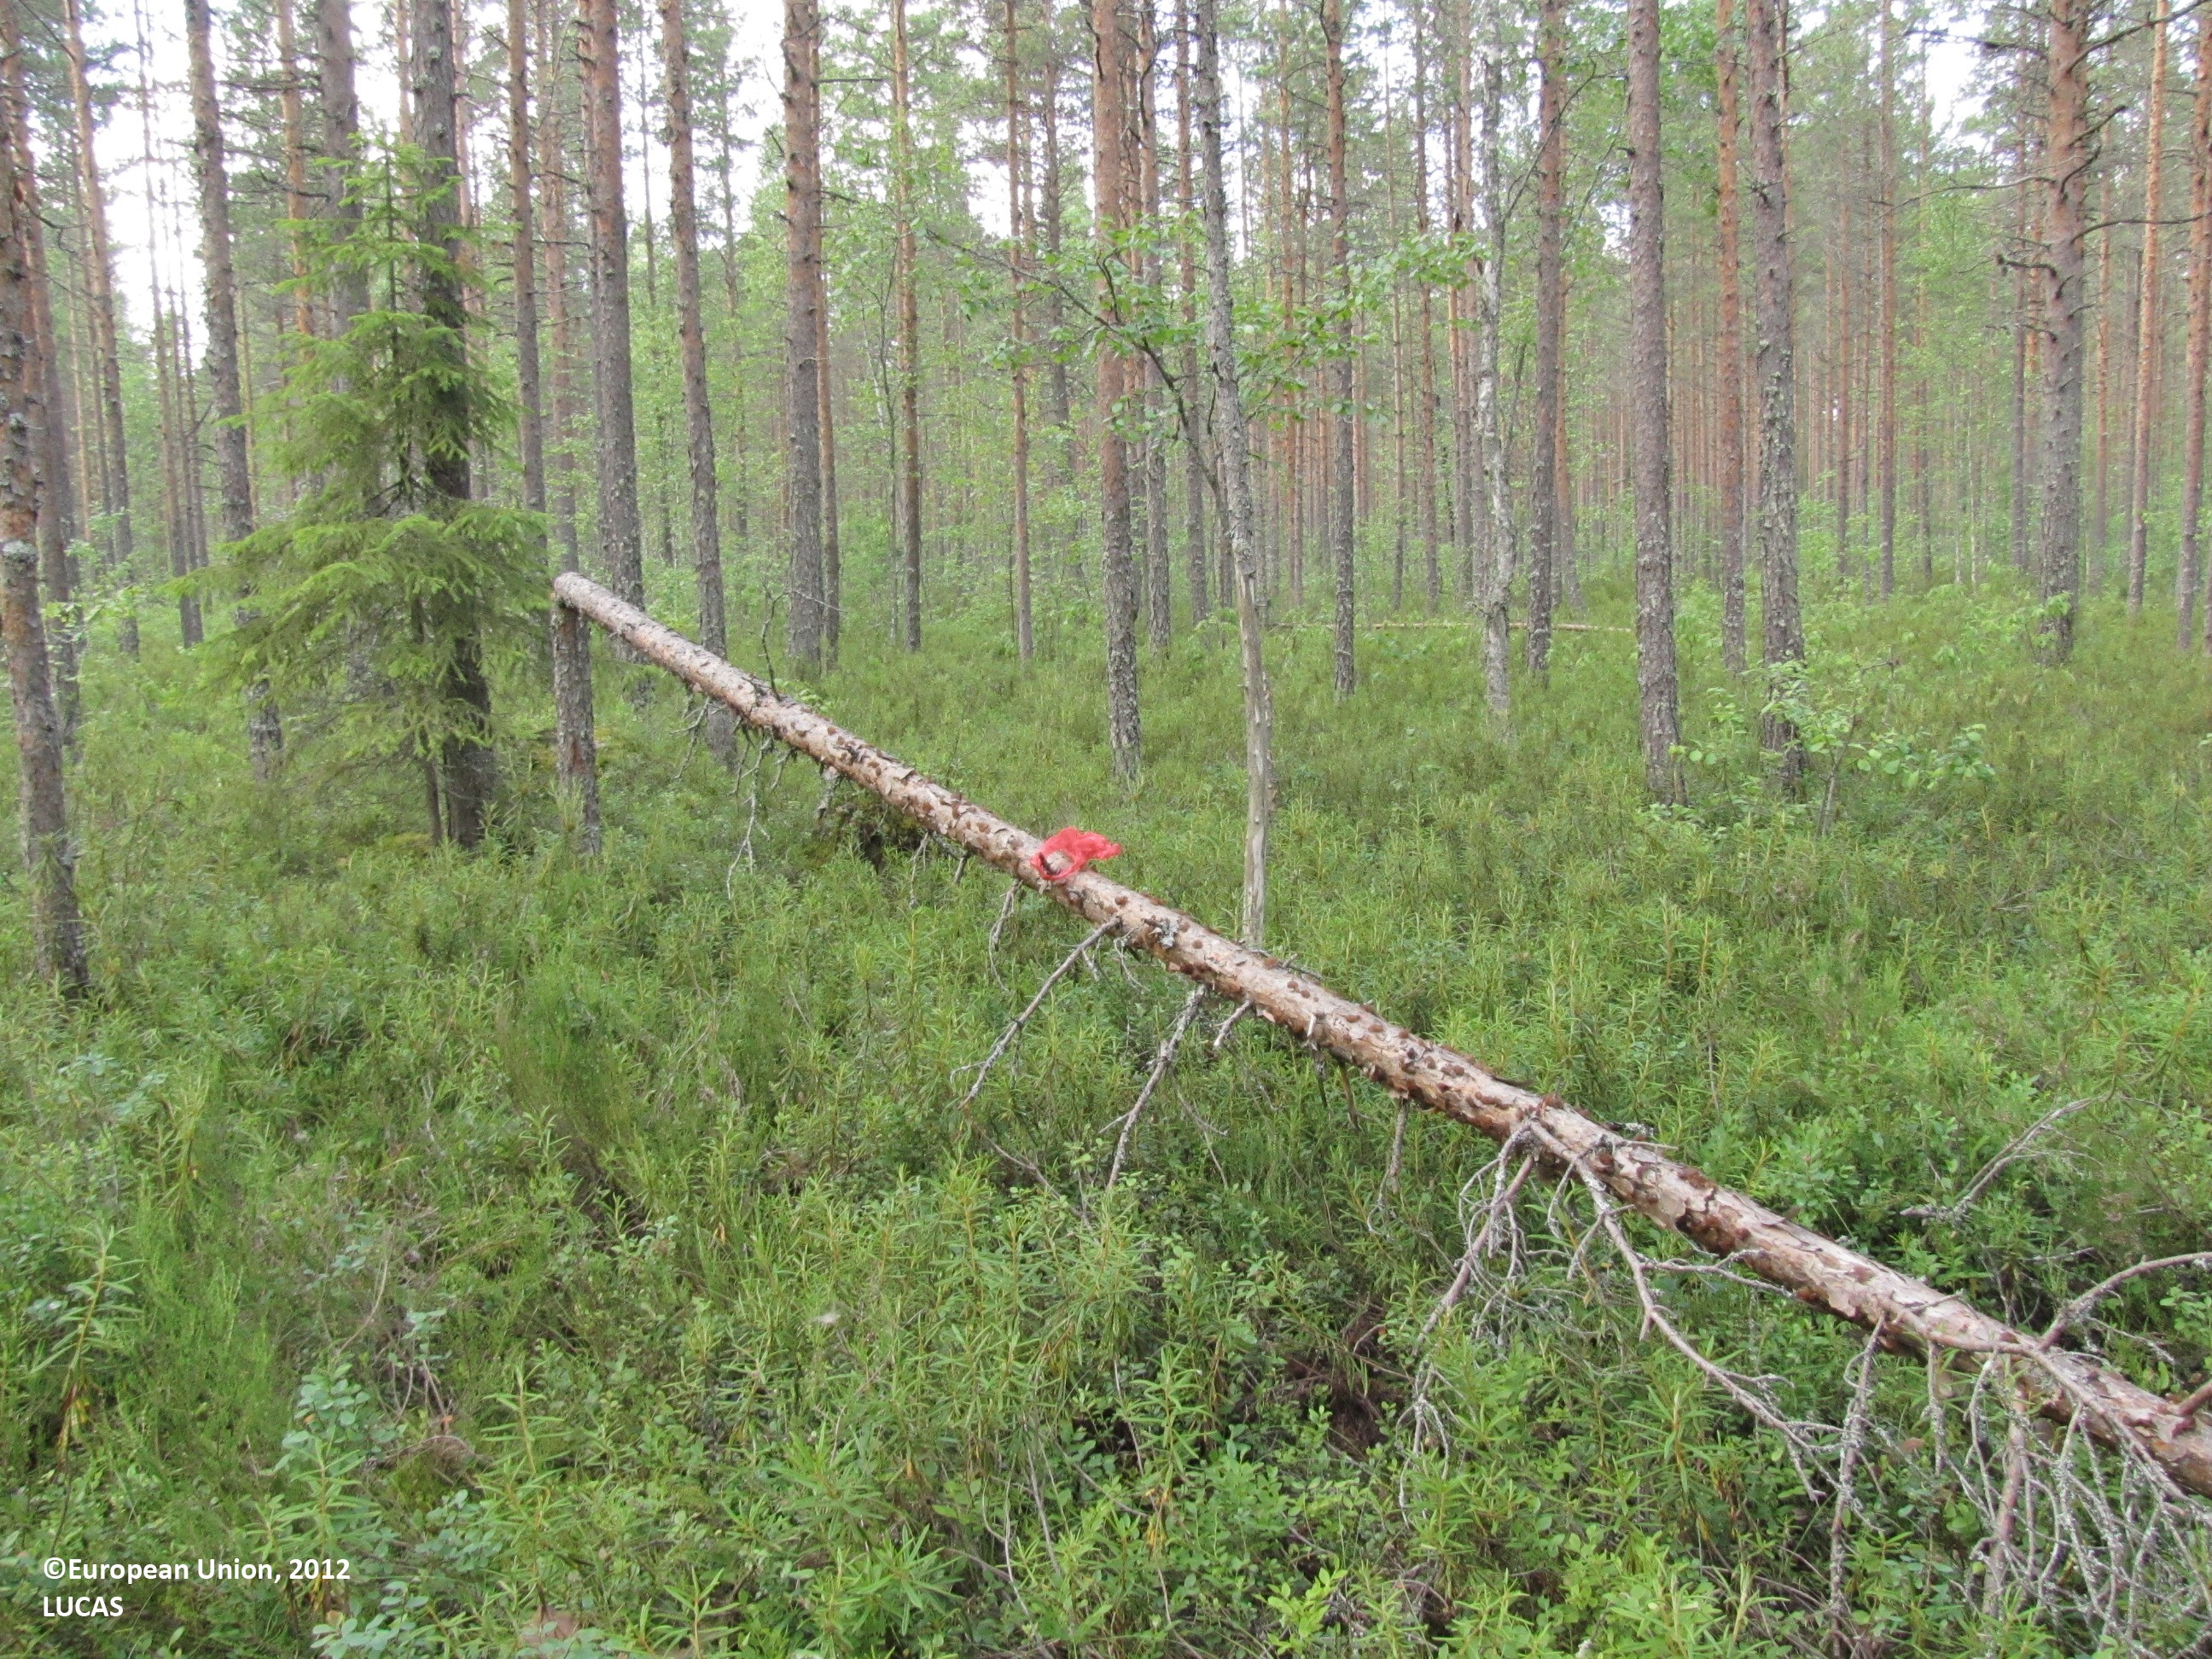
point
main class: Woodland
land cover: Pine dominated coniferous woodland
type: mire and swamp forests
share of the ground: 50 - 75 %
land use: Forestry
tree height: > 5 m
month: July
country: FI
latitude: 62.3672
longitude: 23.5044
